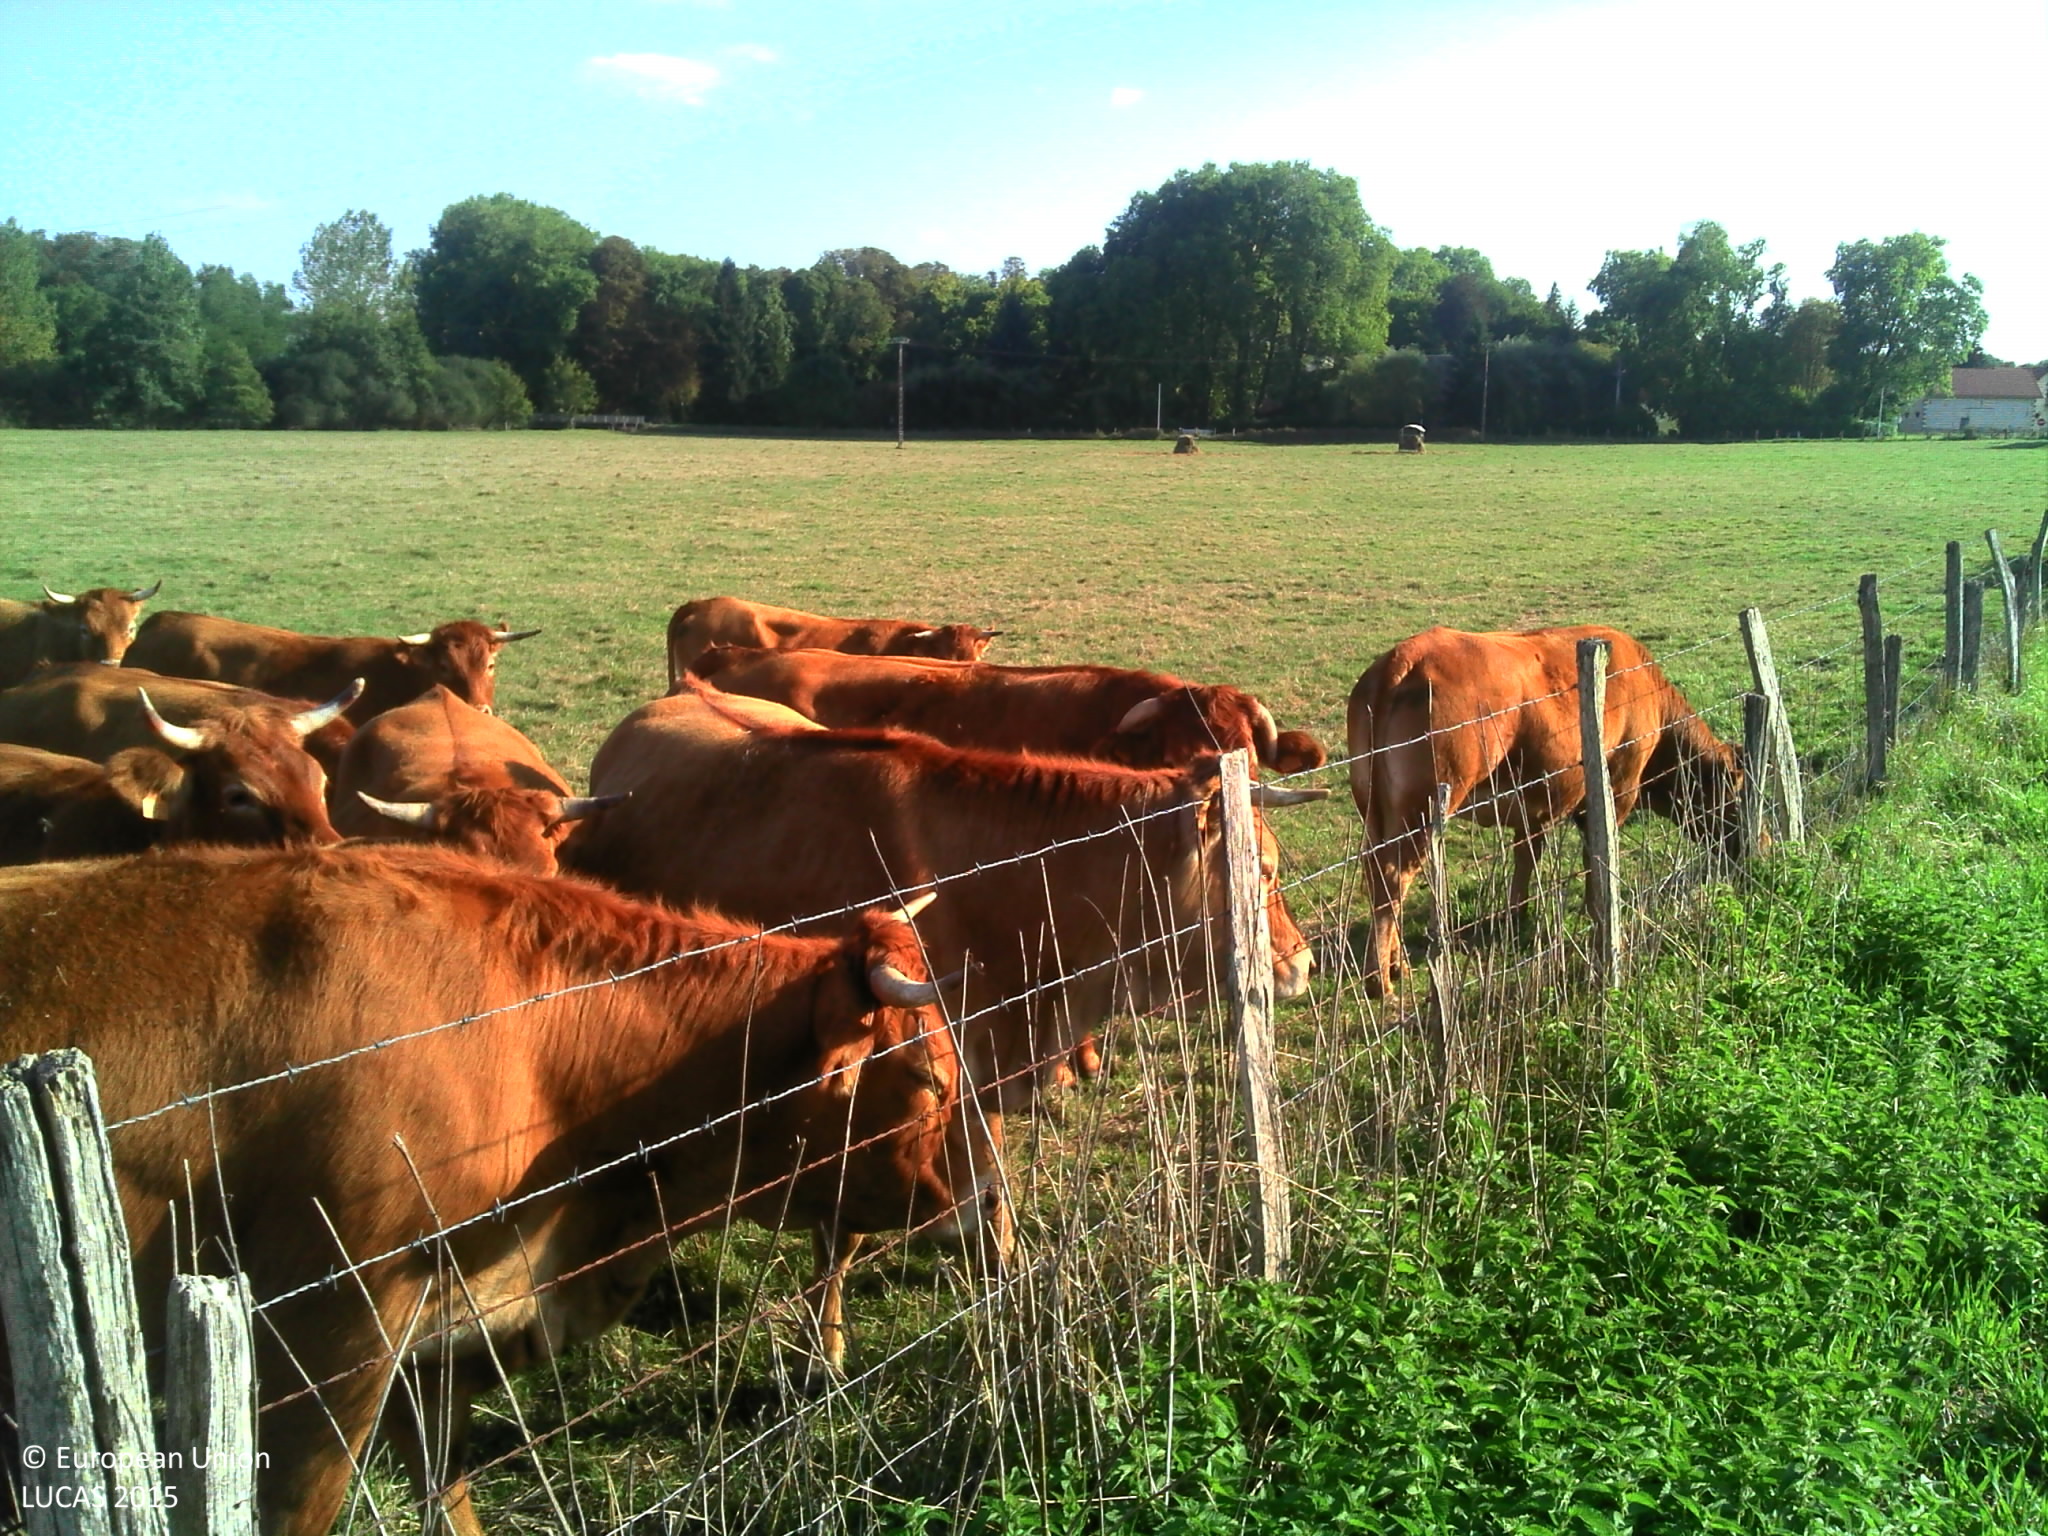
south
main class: Grassland
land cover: Grassland without tree/shrub cover
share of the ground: > 75 %
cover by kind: herbaceous plants 95 %, unconsolidated bare surface 5 %
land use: Agriculture (excluding fallow land and kitchen gardens)
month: September
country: FR
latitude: 47.0641
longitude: 1.5215
